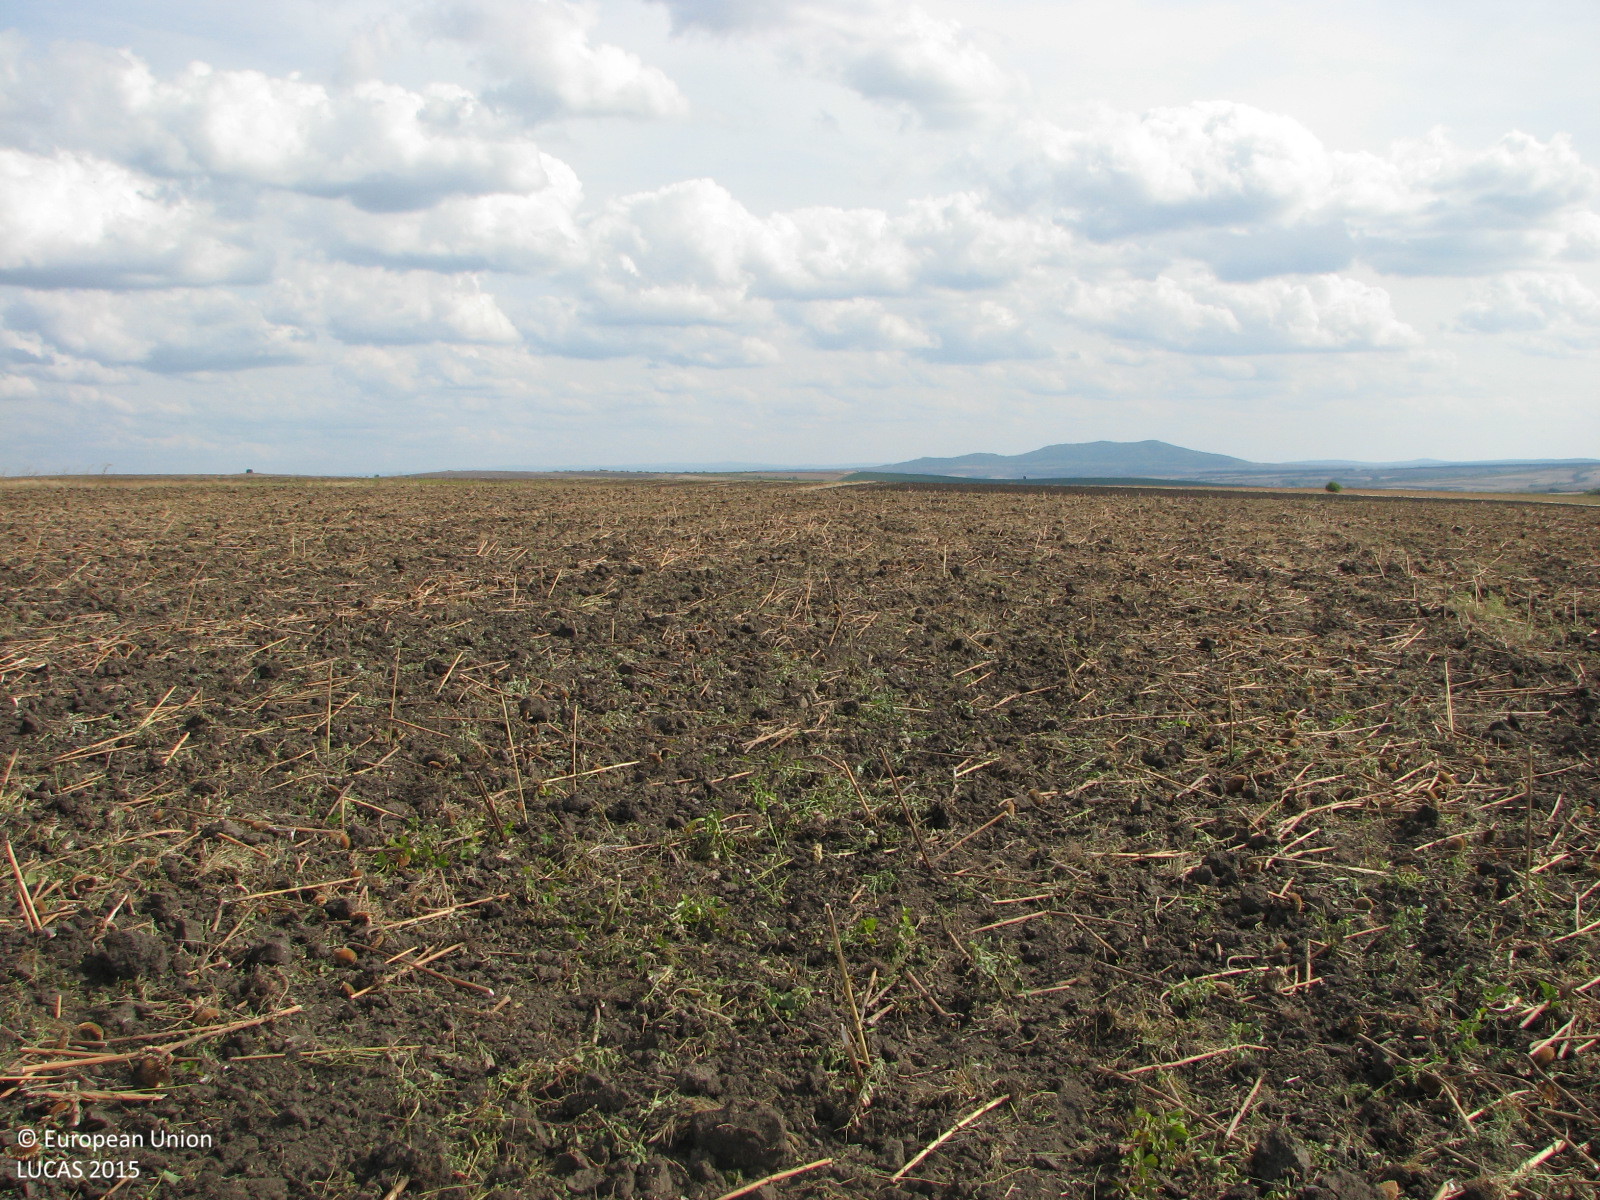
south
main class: Cropland
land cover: Sunflower
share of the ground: < 10 %
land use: Agriculture (excluding fallow land and kitchen gardens)
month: September
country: BG
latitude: 42.4938
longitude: 26.7804
